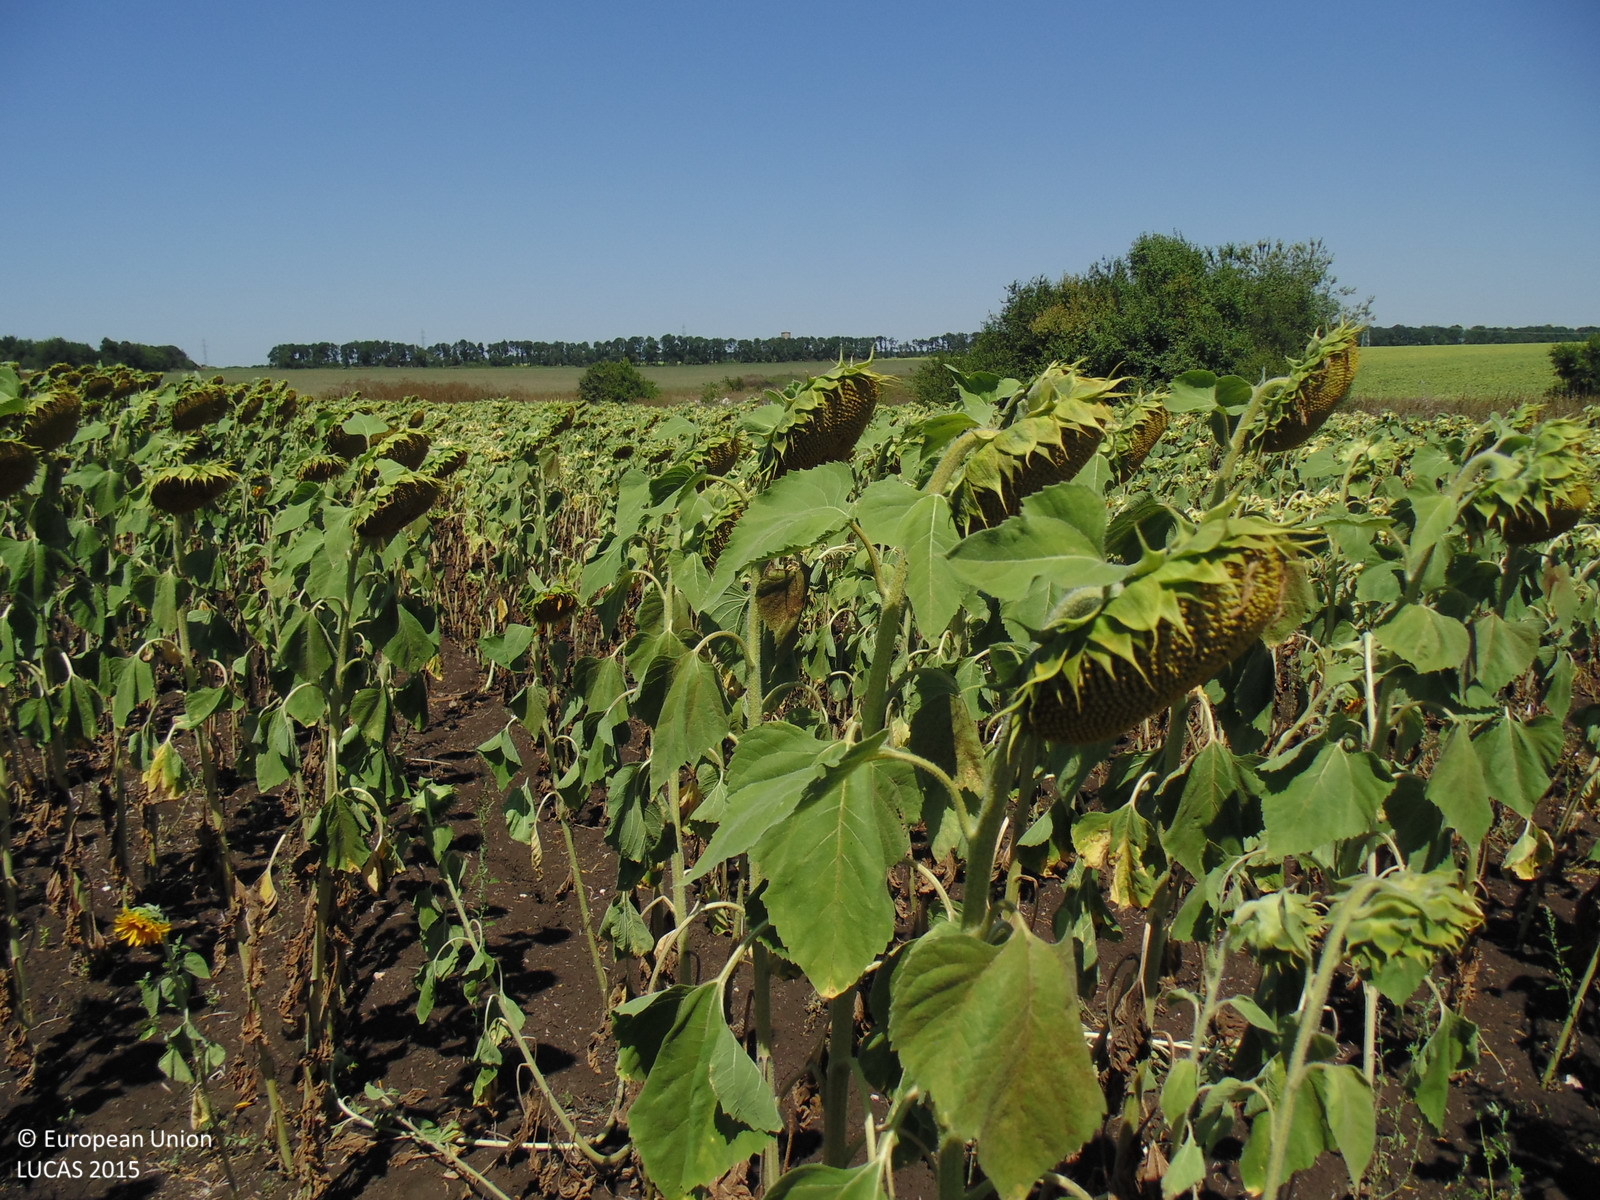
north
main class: Cropland
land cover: Sunflower
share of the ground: > 75 %
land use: Agriculture (excluding fallow land and kitchen gardens)
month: August
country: BG
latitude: 43.5045
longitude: 28.1716
